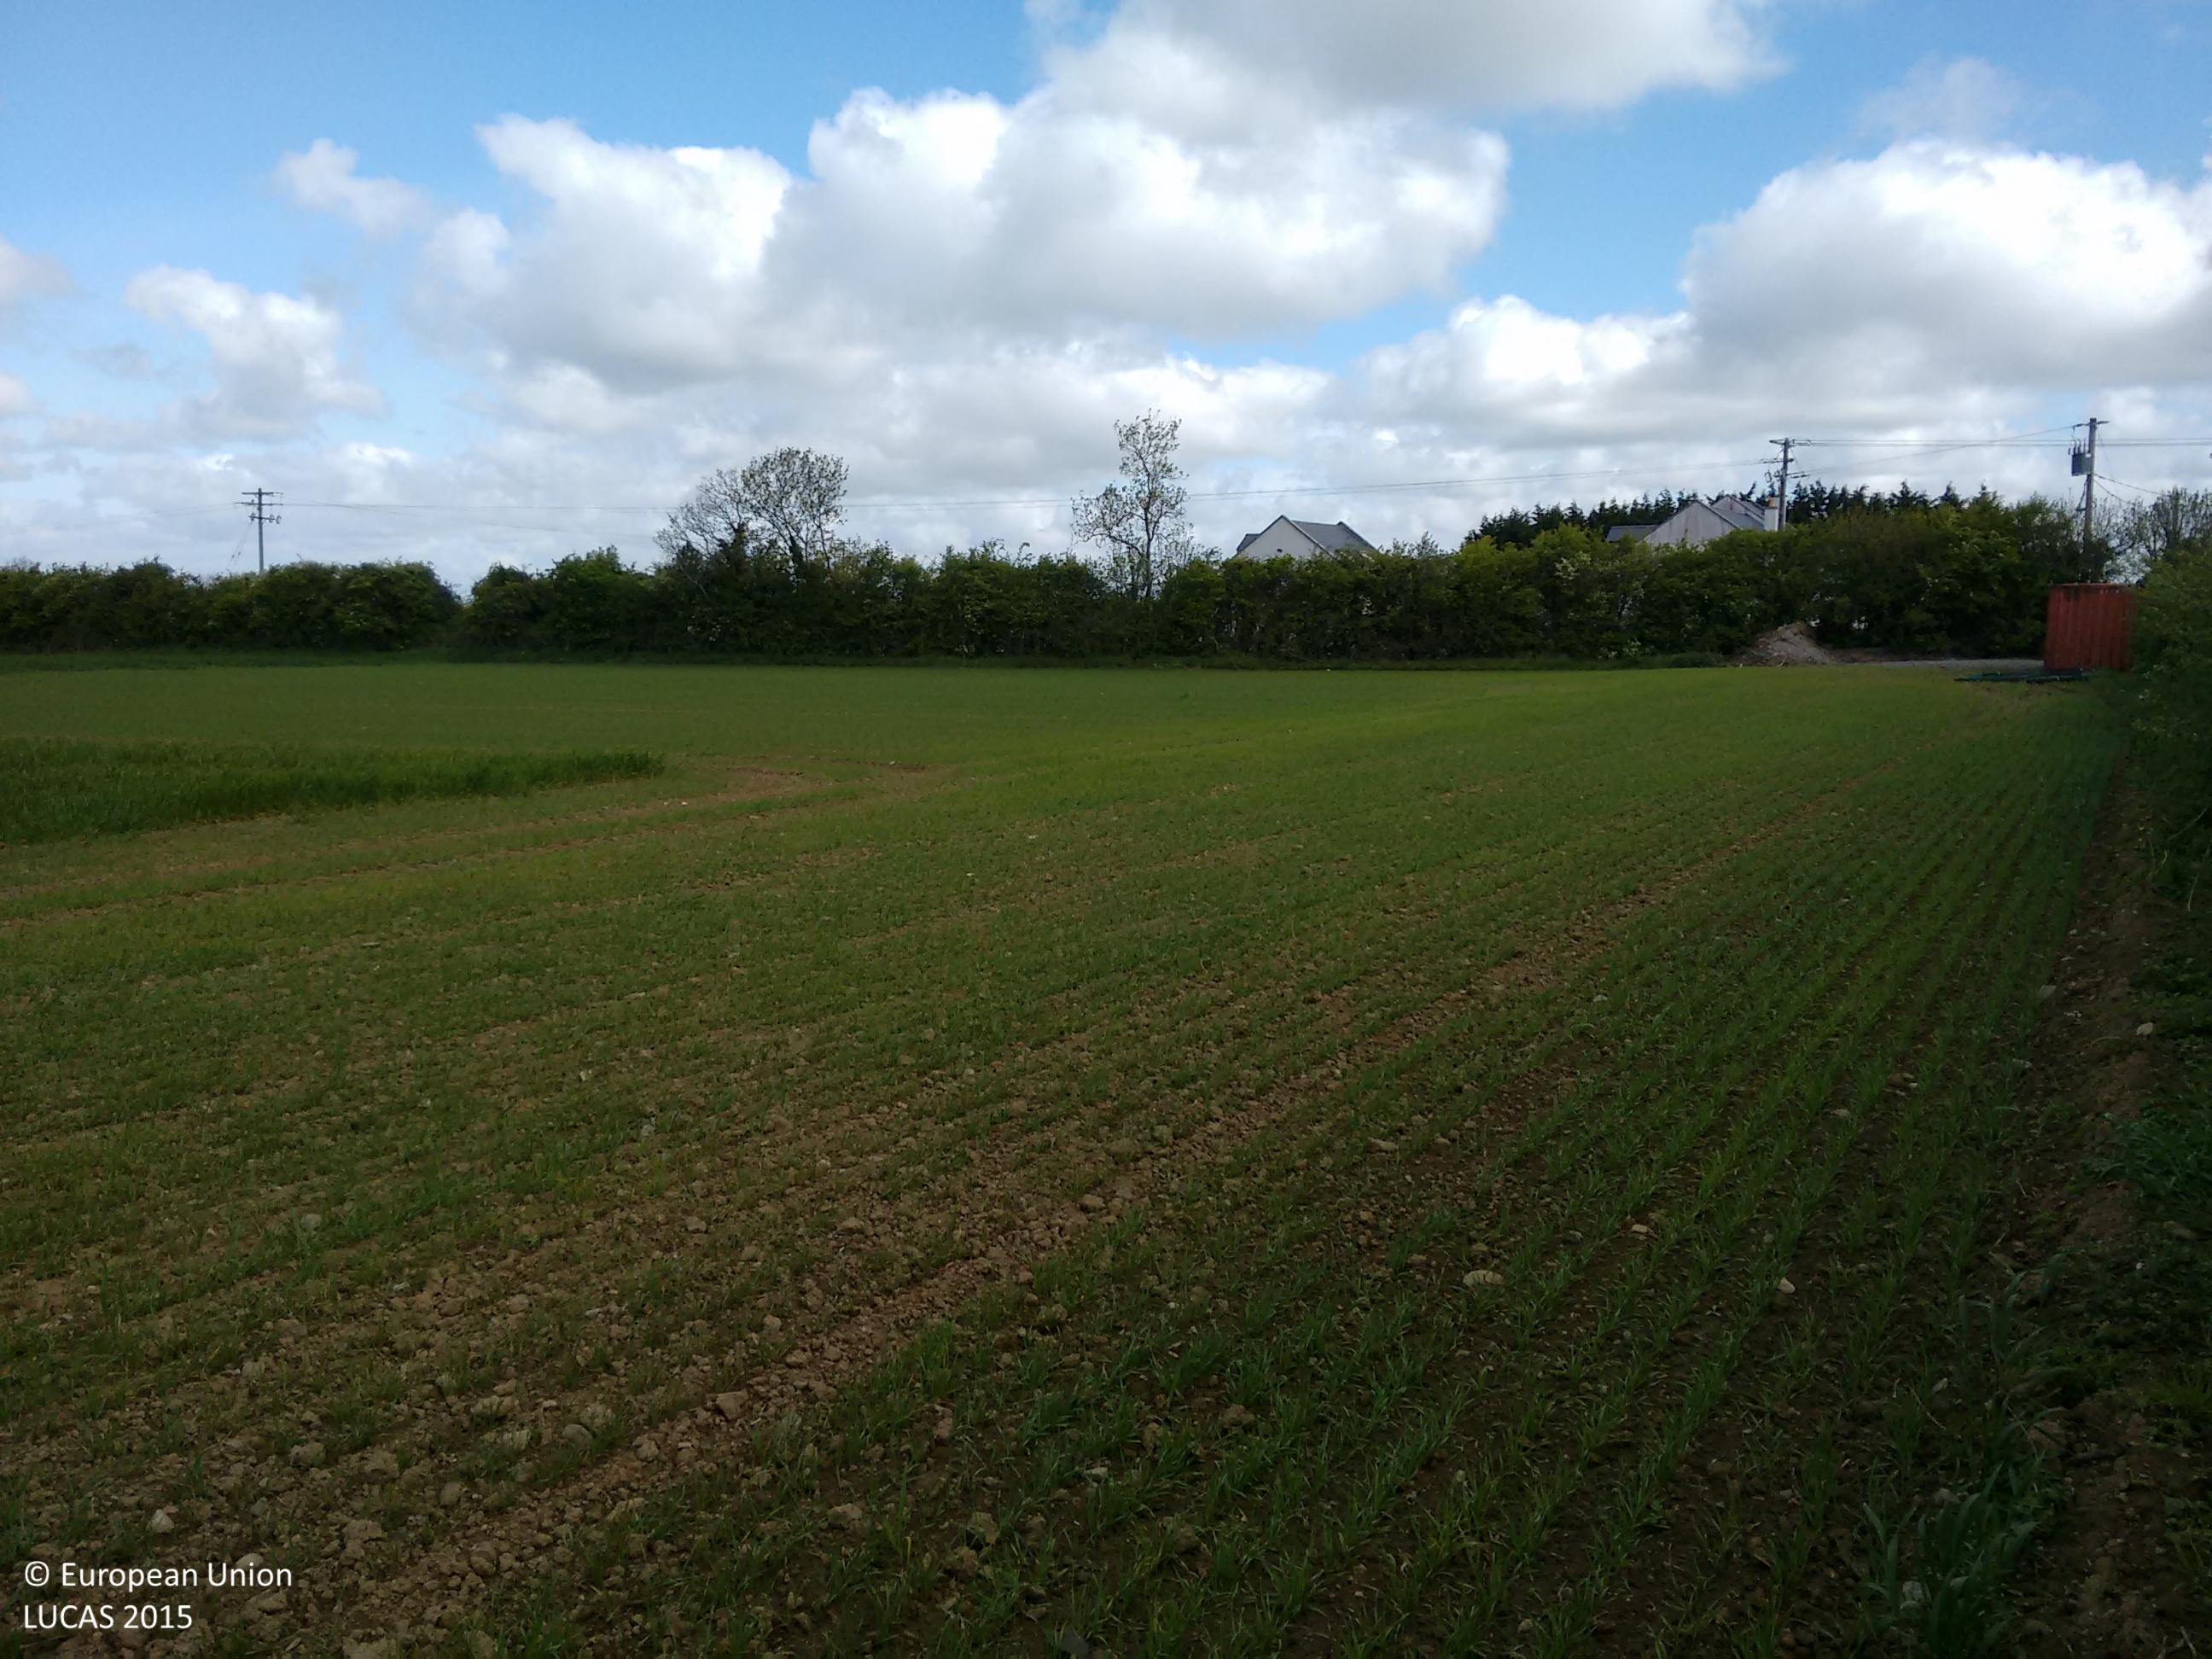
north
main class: Cropland
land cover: Barley
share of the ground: 50 - 75 %
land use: Agriculture (excluding fallow land and kitchen gardens)
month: May
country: IE
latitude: 53.3061
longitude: -6.4996
